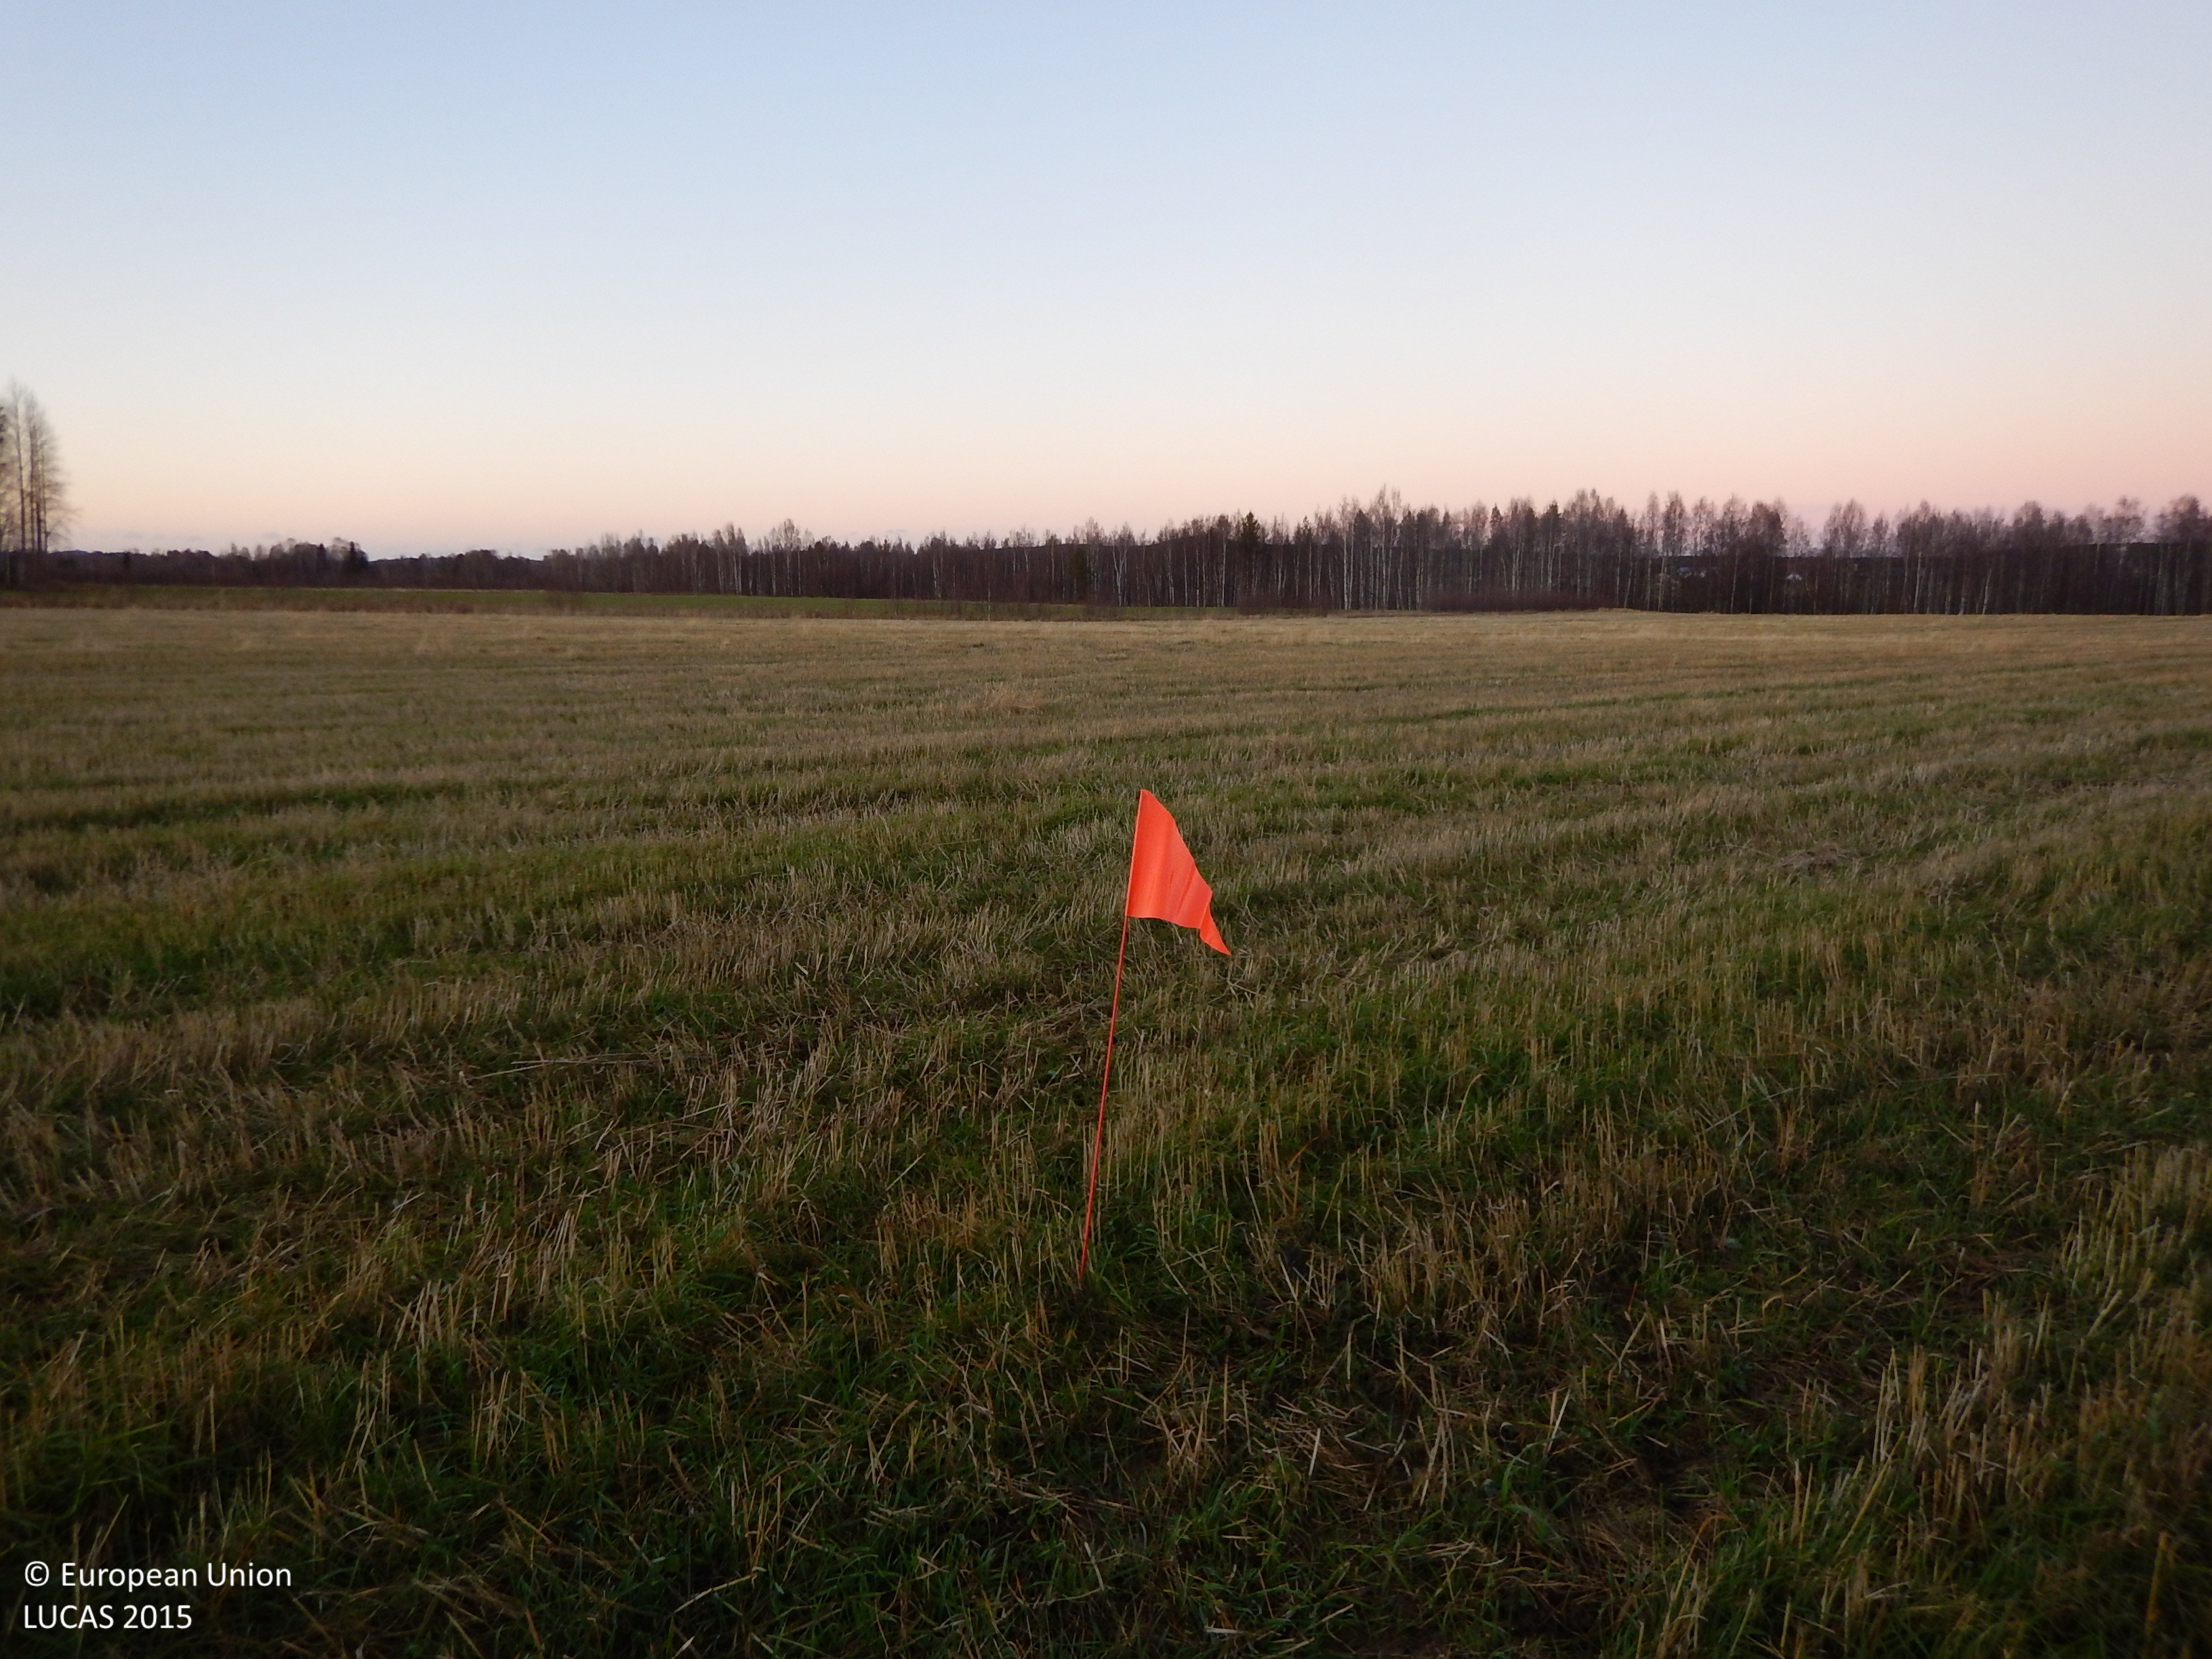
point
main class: Cropland
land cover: Temporary grasslands
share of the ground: > 75 %
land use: Agriculture (excluding fallow land and kitchen gardens)
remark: Harvested field
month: November
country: SE
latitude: 65.3351
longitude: 21.2057
